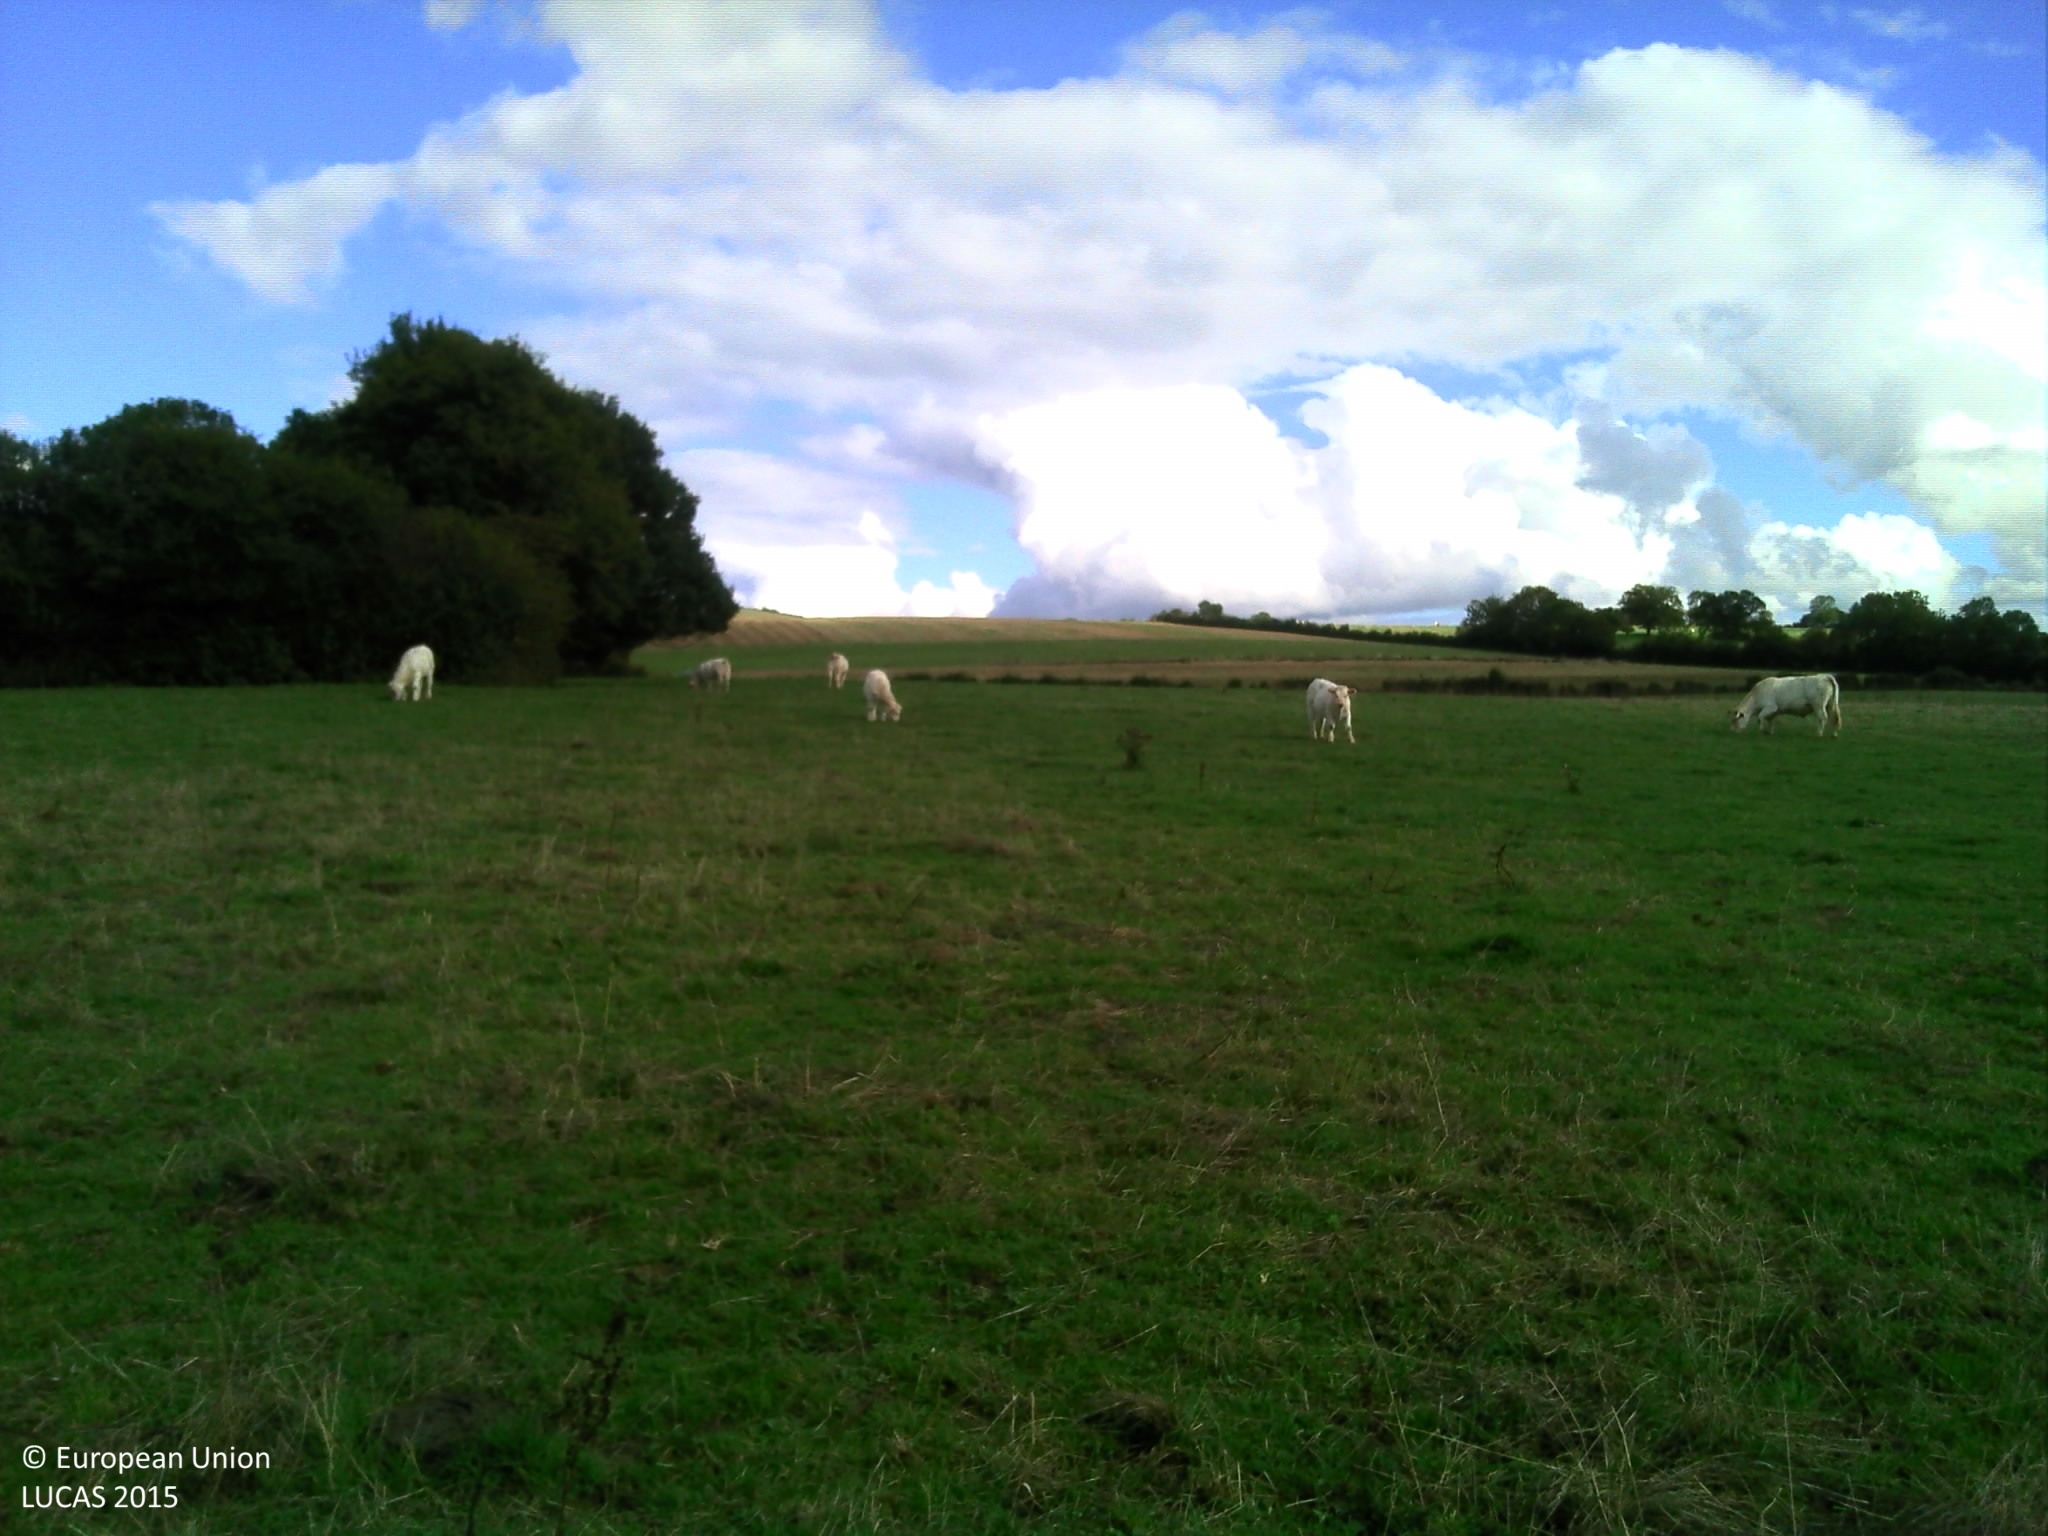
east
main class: Grassland
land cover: Grassland without tree/shrub cover
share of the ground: > 75 %
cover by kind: herbaceous plants 100 %
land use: Agriculture (excluding fallow land and kitchen gardens)
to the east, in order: Grassland without tree/shrub cover; Fences; Abandoned hedges; Tracks; Other bare soil
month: September
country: FR
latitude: 47.2133
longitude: 4.3614
